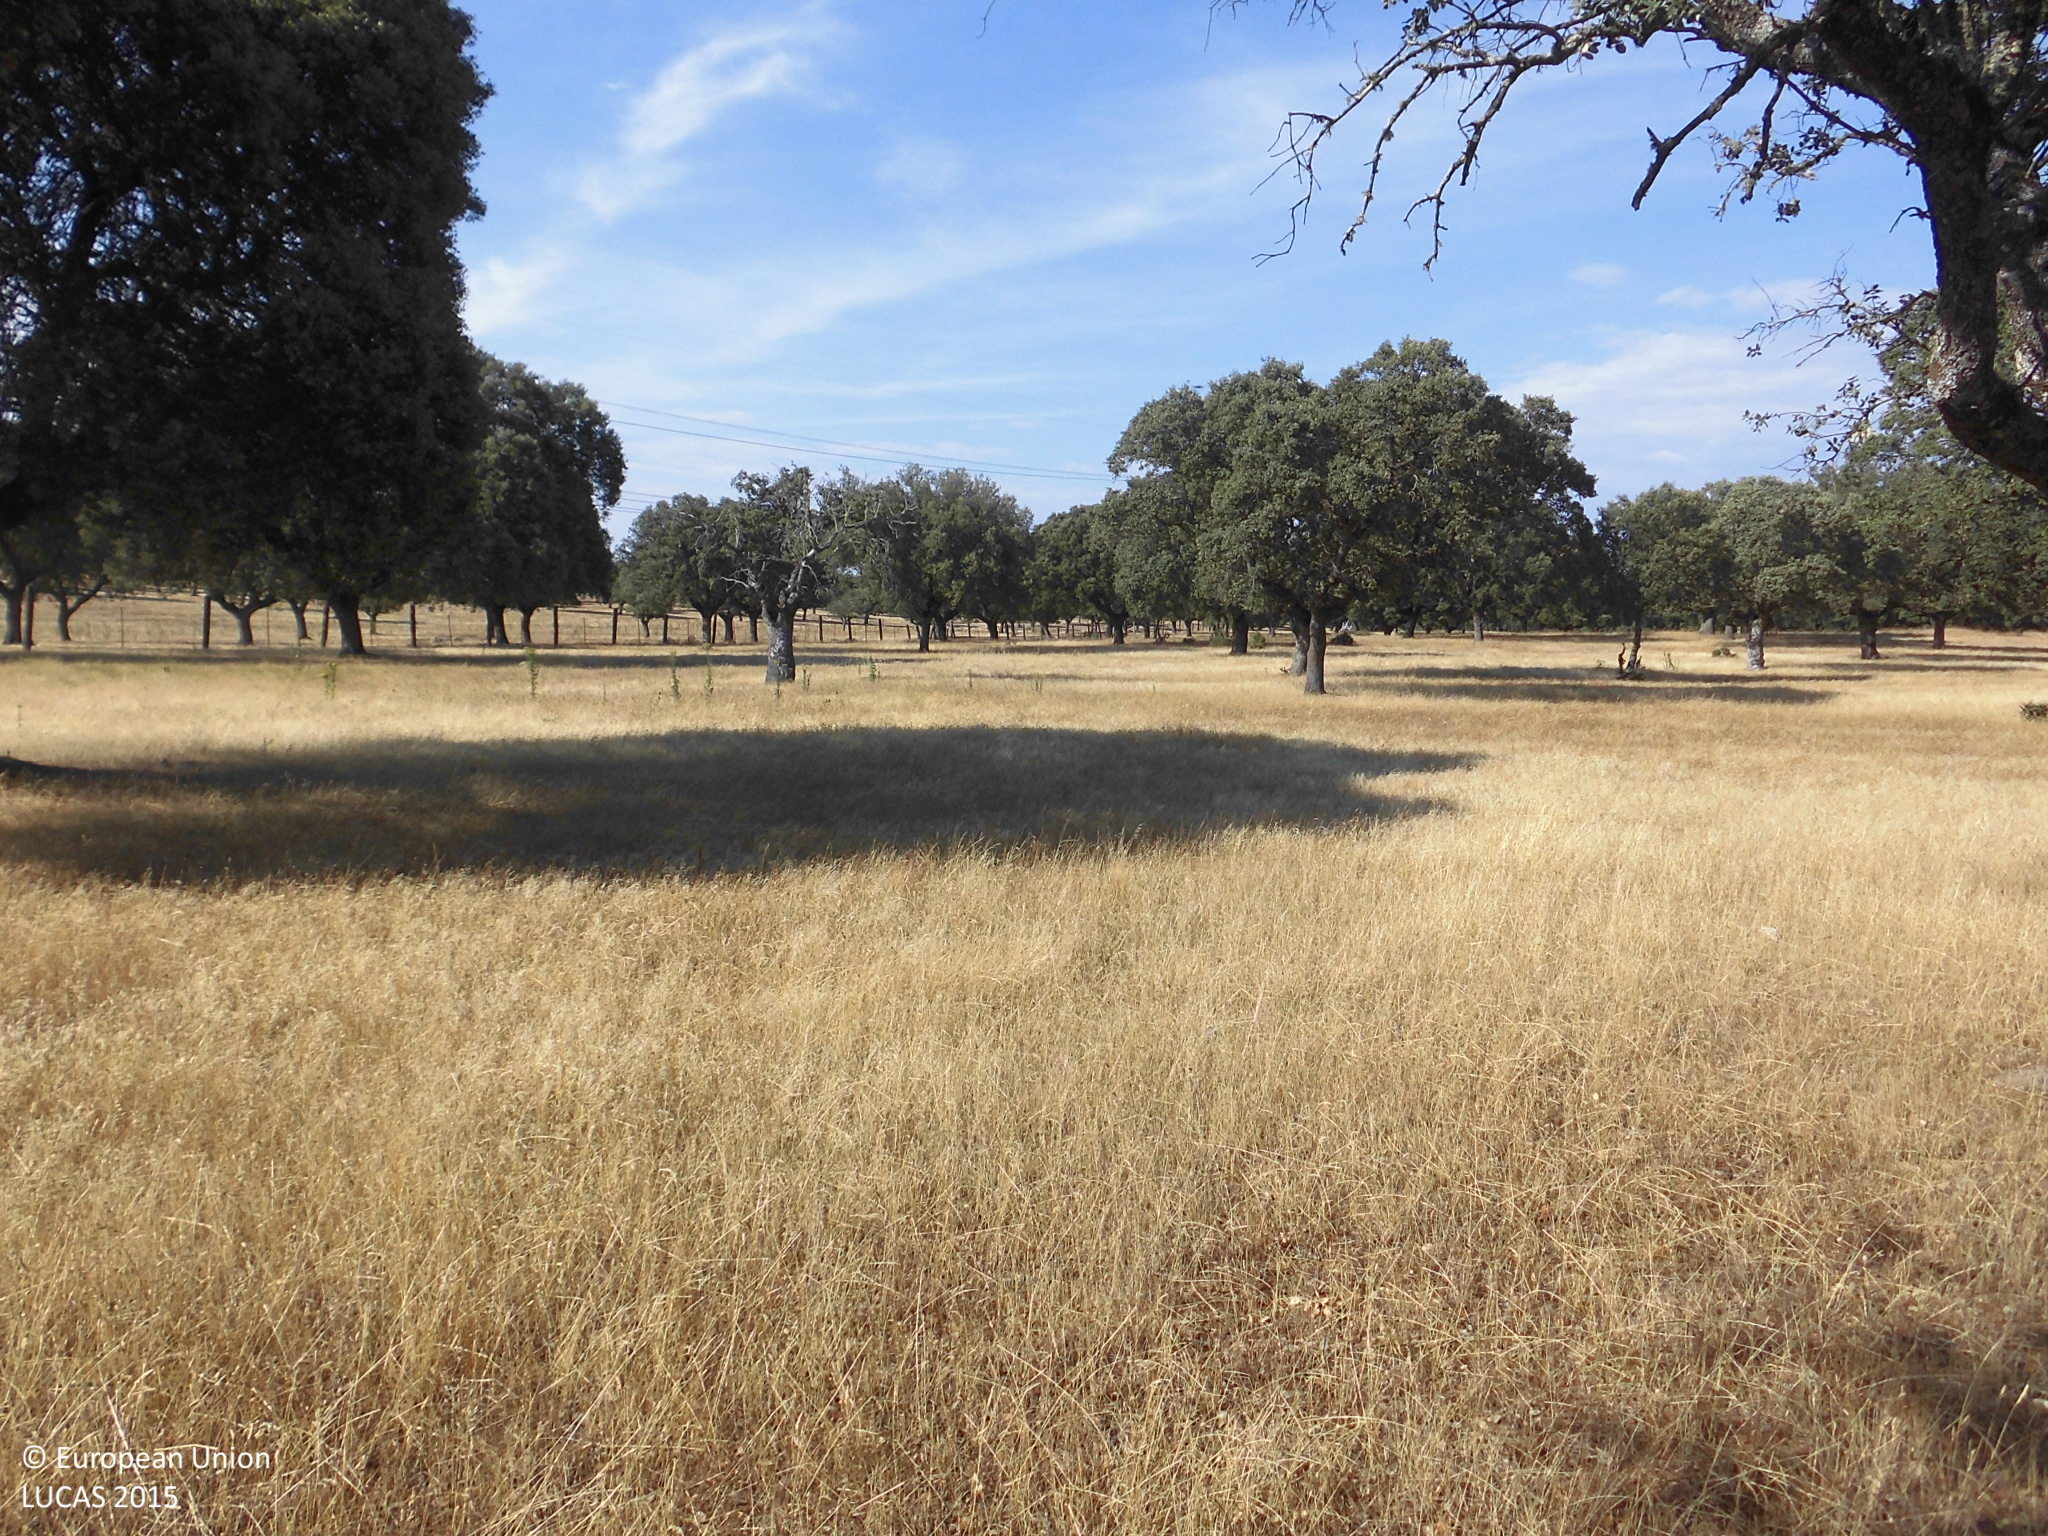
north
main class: Woodland
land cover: Broadleaved woodland
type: broadleaved evergreen forest
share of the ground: 25 - 50 %
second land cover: Grassland without tree/shrub cover
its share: > 75 %
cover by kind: broadleaved forest trees 50 %, herbaceous plants 50 %
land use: Forestry
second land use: Agriculture (excluding fallow land and kitchen gardens)
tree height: > 5 m
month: June
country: ES
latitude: 39.9376
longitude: -6.1148
